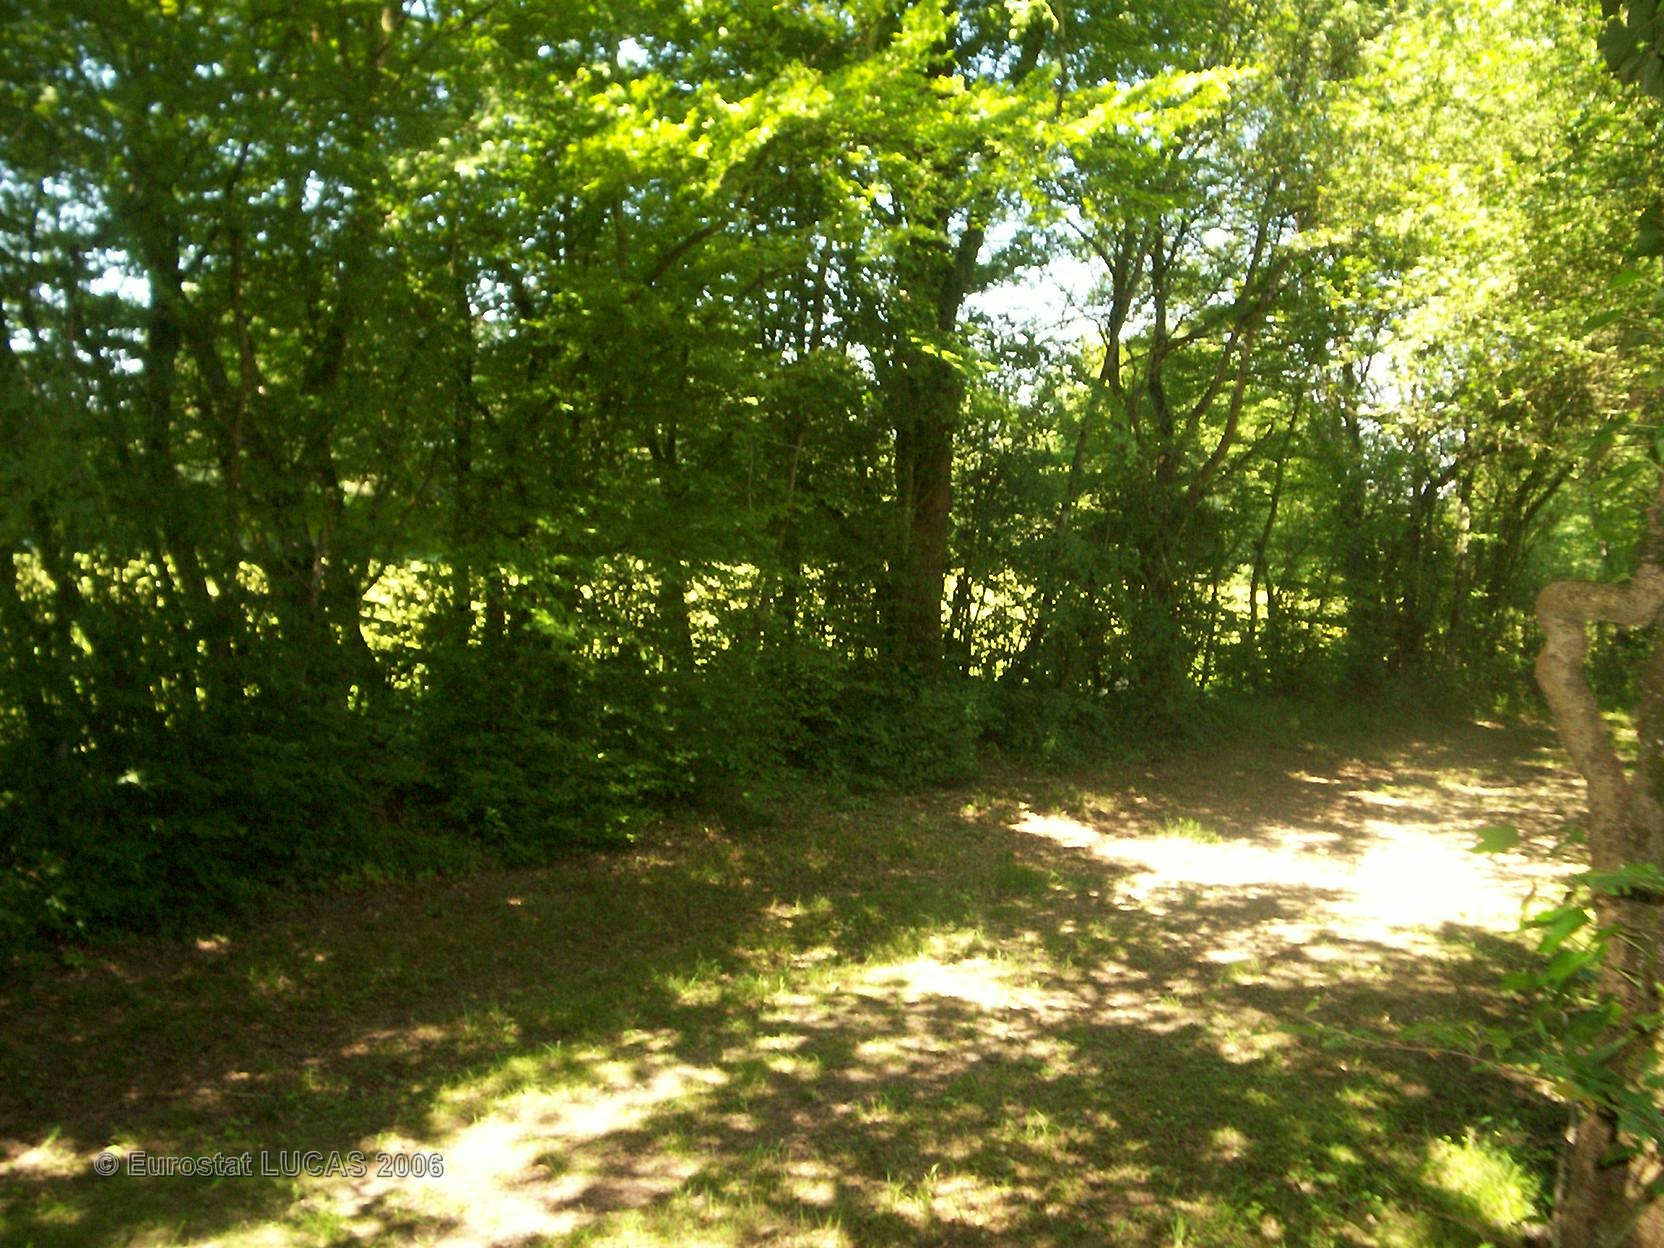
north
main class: Grassland
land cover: Grassland with sparse tree/shrub cover
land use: Agriculture (excluding fallow land and kitchen gardens)
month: June
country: FR
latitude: 46.9560
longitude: 3.0447
